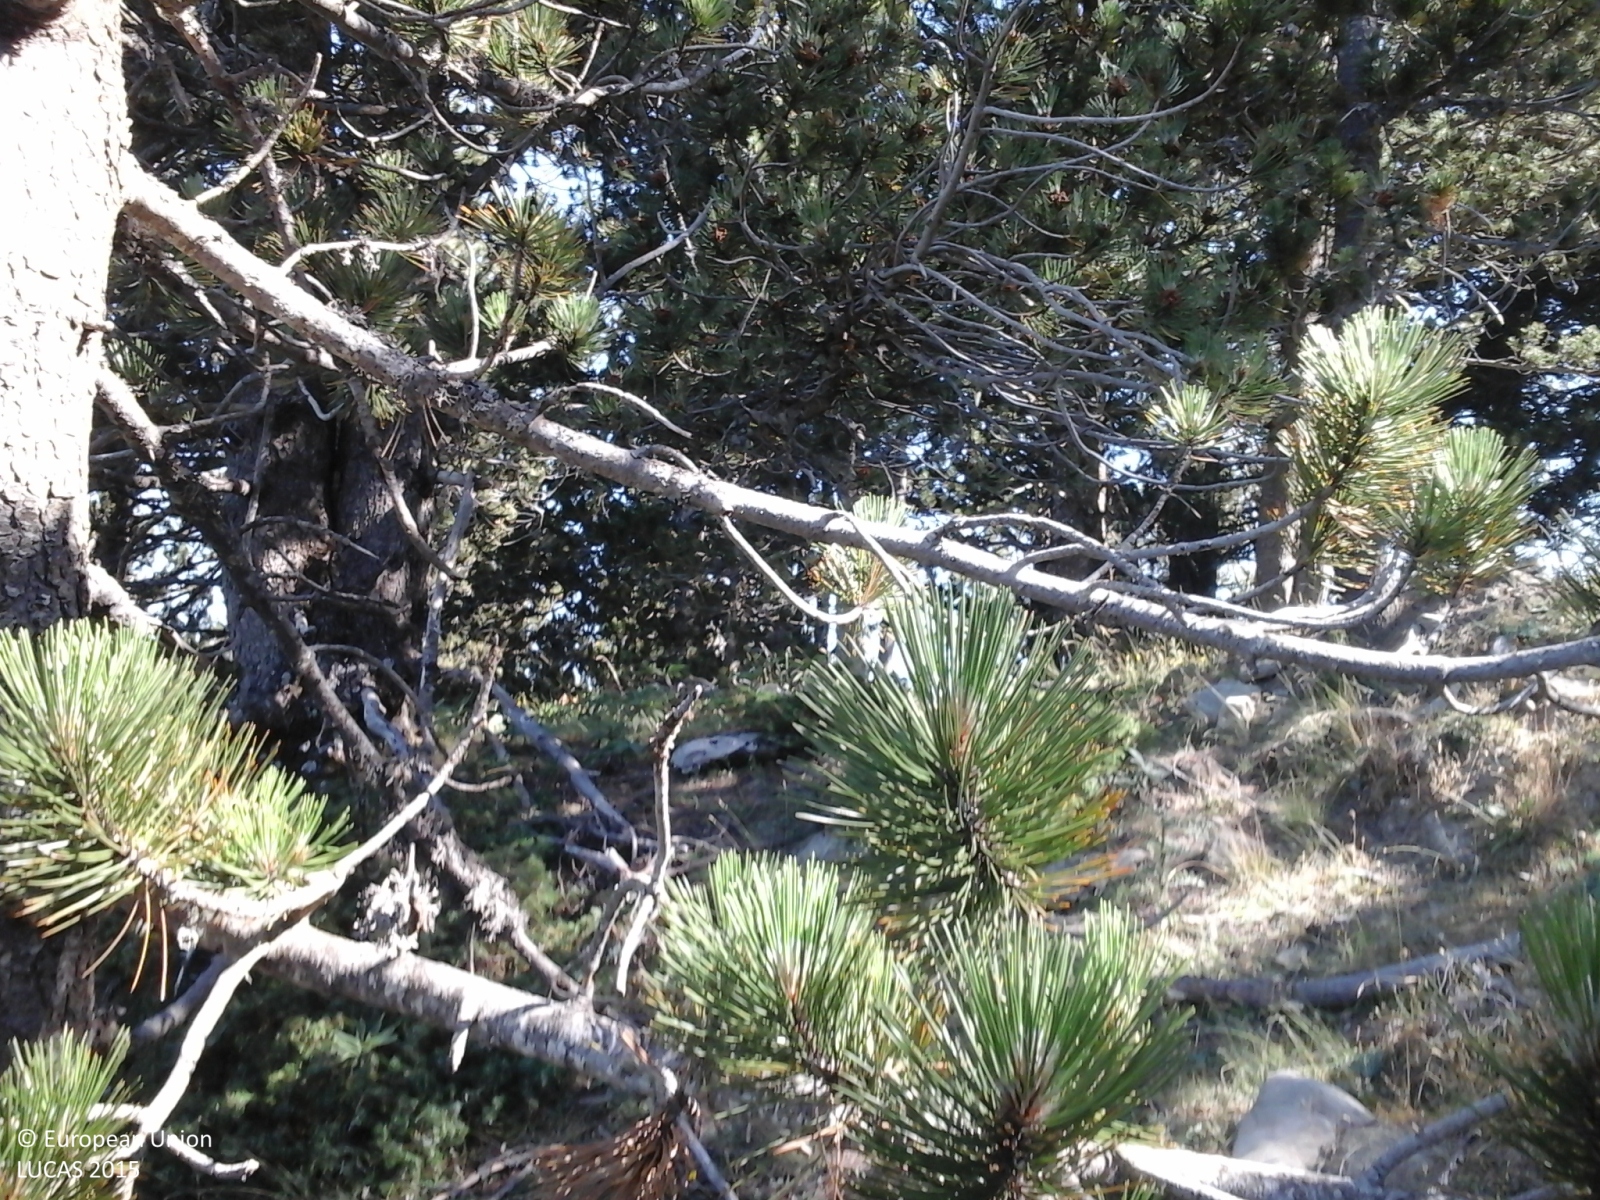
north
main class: Woodland
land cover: Pine dominated coniferous woodland
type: coniferous forest of the mediterranean region
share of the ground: 50 - 75 %
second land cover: Grassland without tree/shrub cover
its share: 10 - 25 %
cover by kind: coniferous forest trees 70 %, herbaceous plants 20 %, consolidated bare surface 10 %
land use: Forestry
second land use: Agriculture (excluding fallow land and kitchen gardens)
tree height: > 5 m
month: July
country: GR
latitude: 39.7493
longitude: 21.2205
